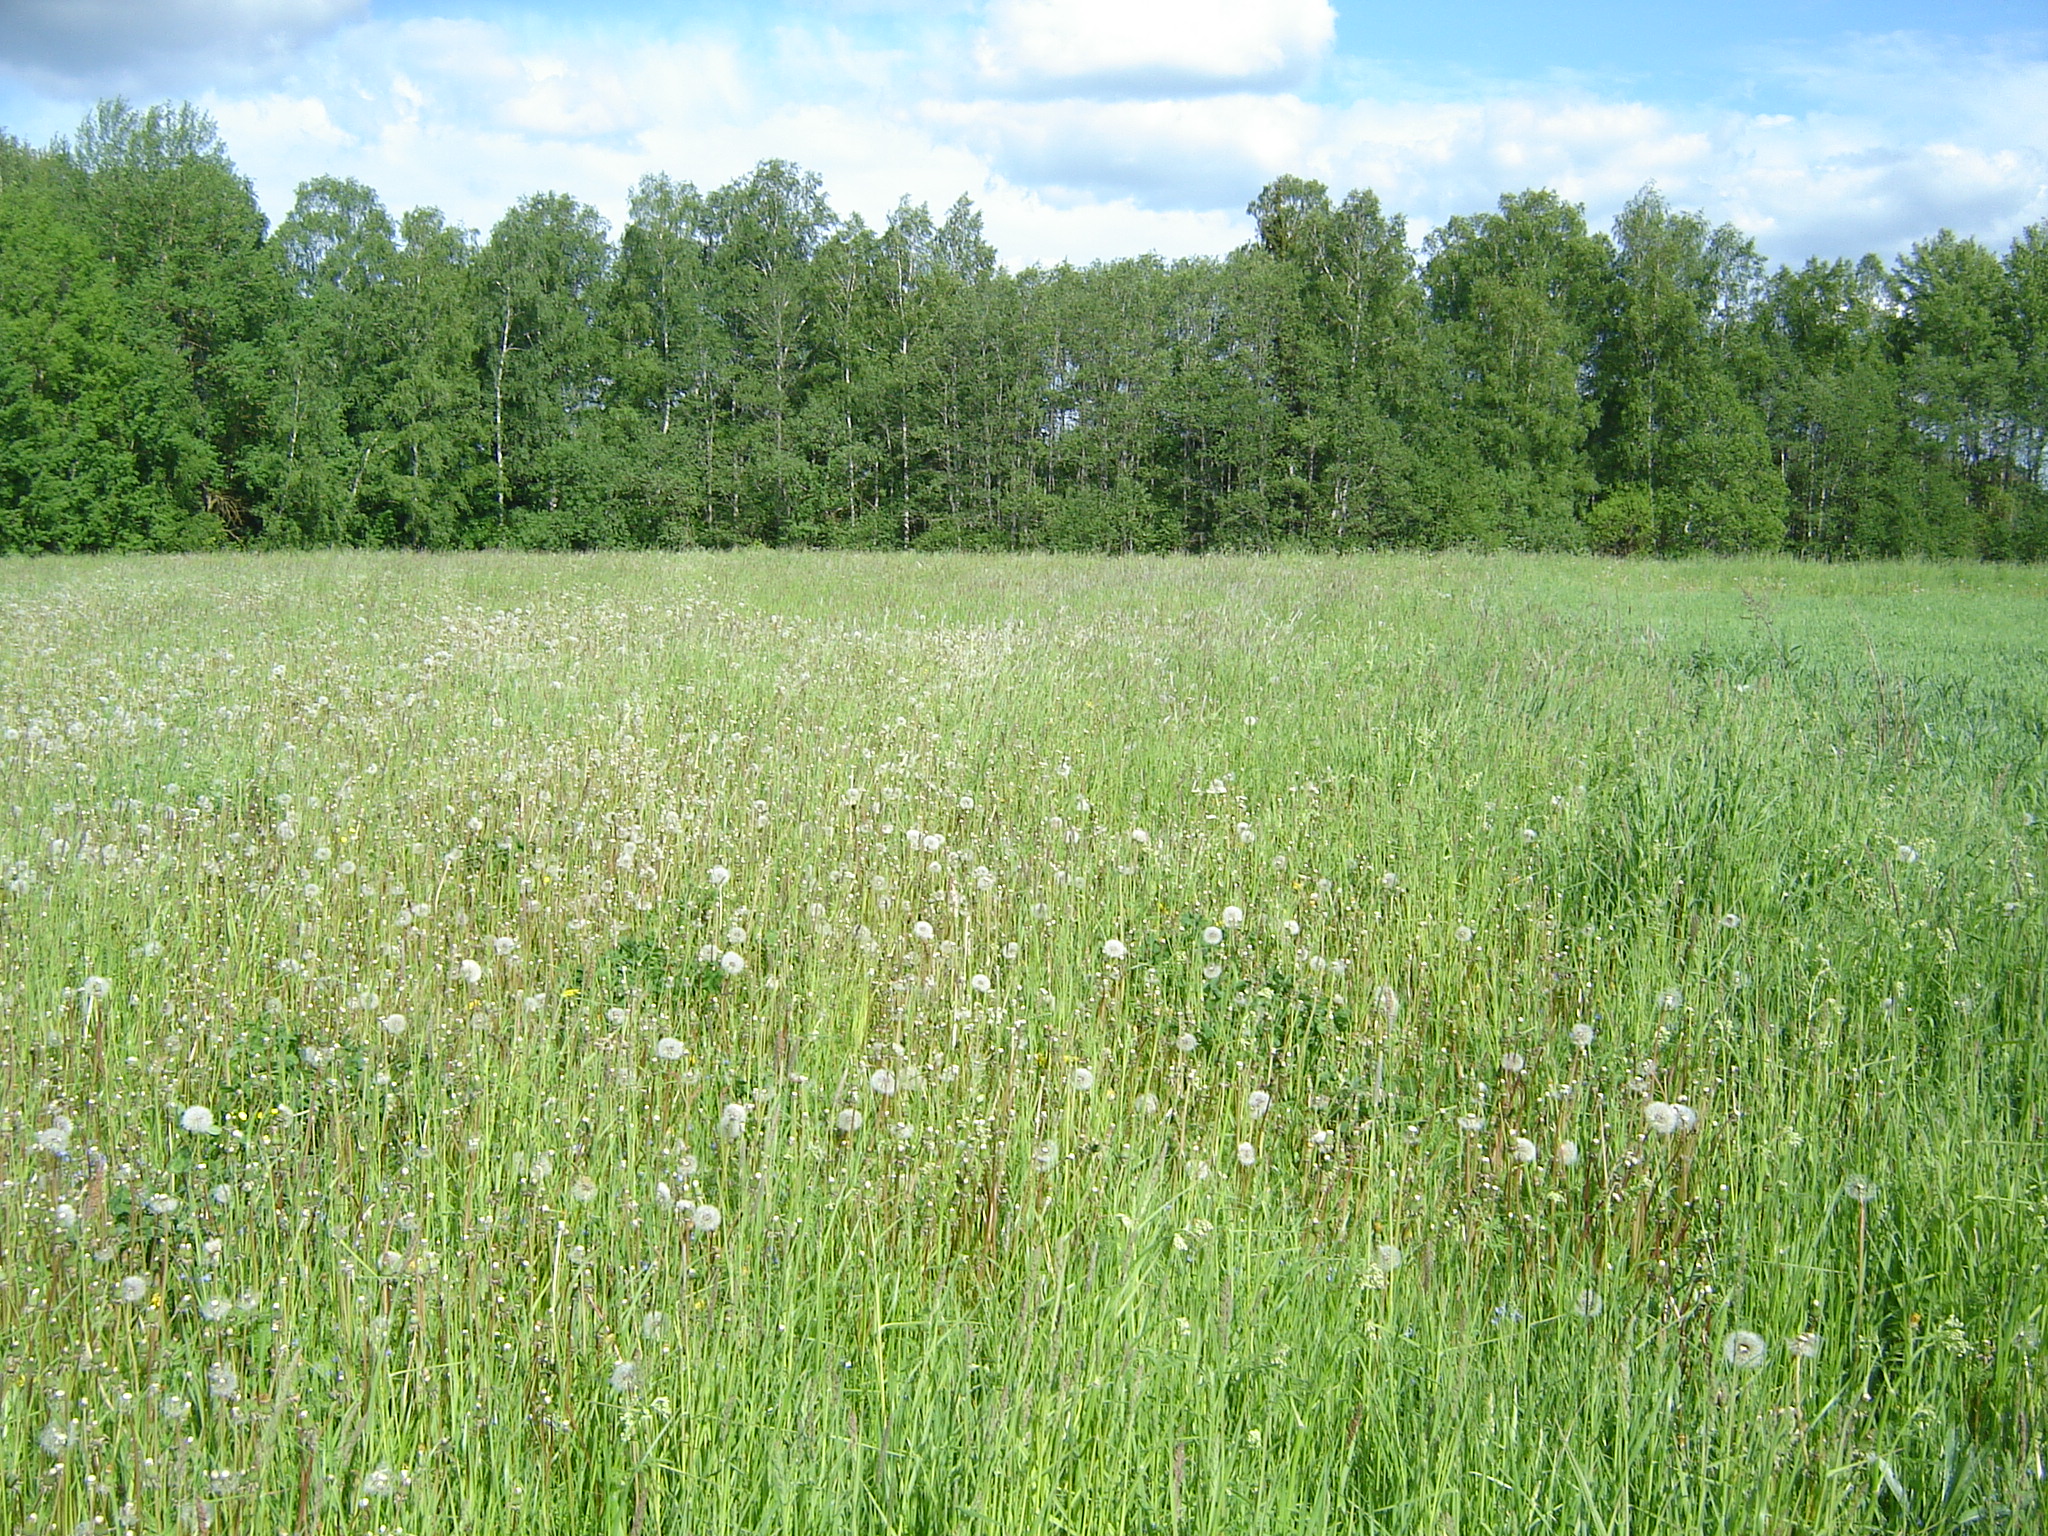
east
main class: Grassland
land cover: Grassland without tree/shrub cover
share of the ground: > 75 %
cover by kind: herbaceous plants 100 %
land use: Agriculture (excluding fallow land and kitchen gardens)
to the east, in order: Grassland without tree/shrub cover; Ditches and canals; Grass margins; Paved roads, cycling and walking lanes; Grass margins; Common wheat; Broadleaved woodland
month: May
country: LT
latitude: 55.7394
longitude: 25.2973
